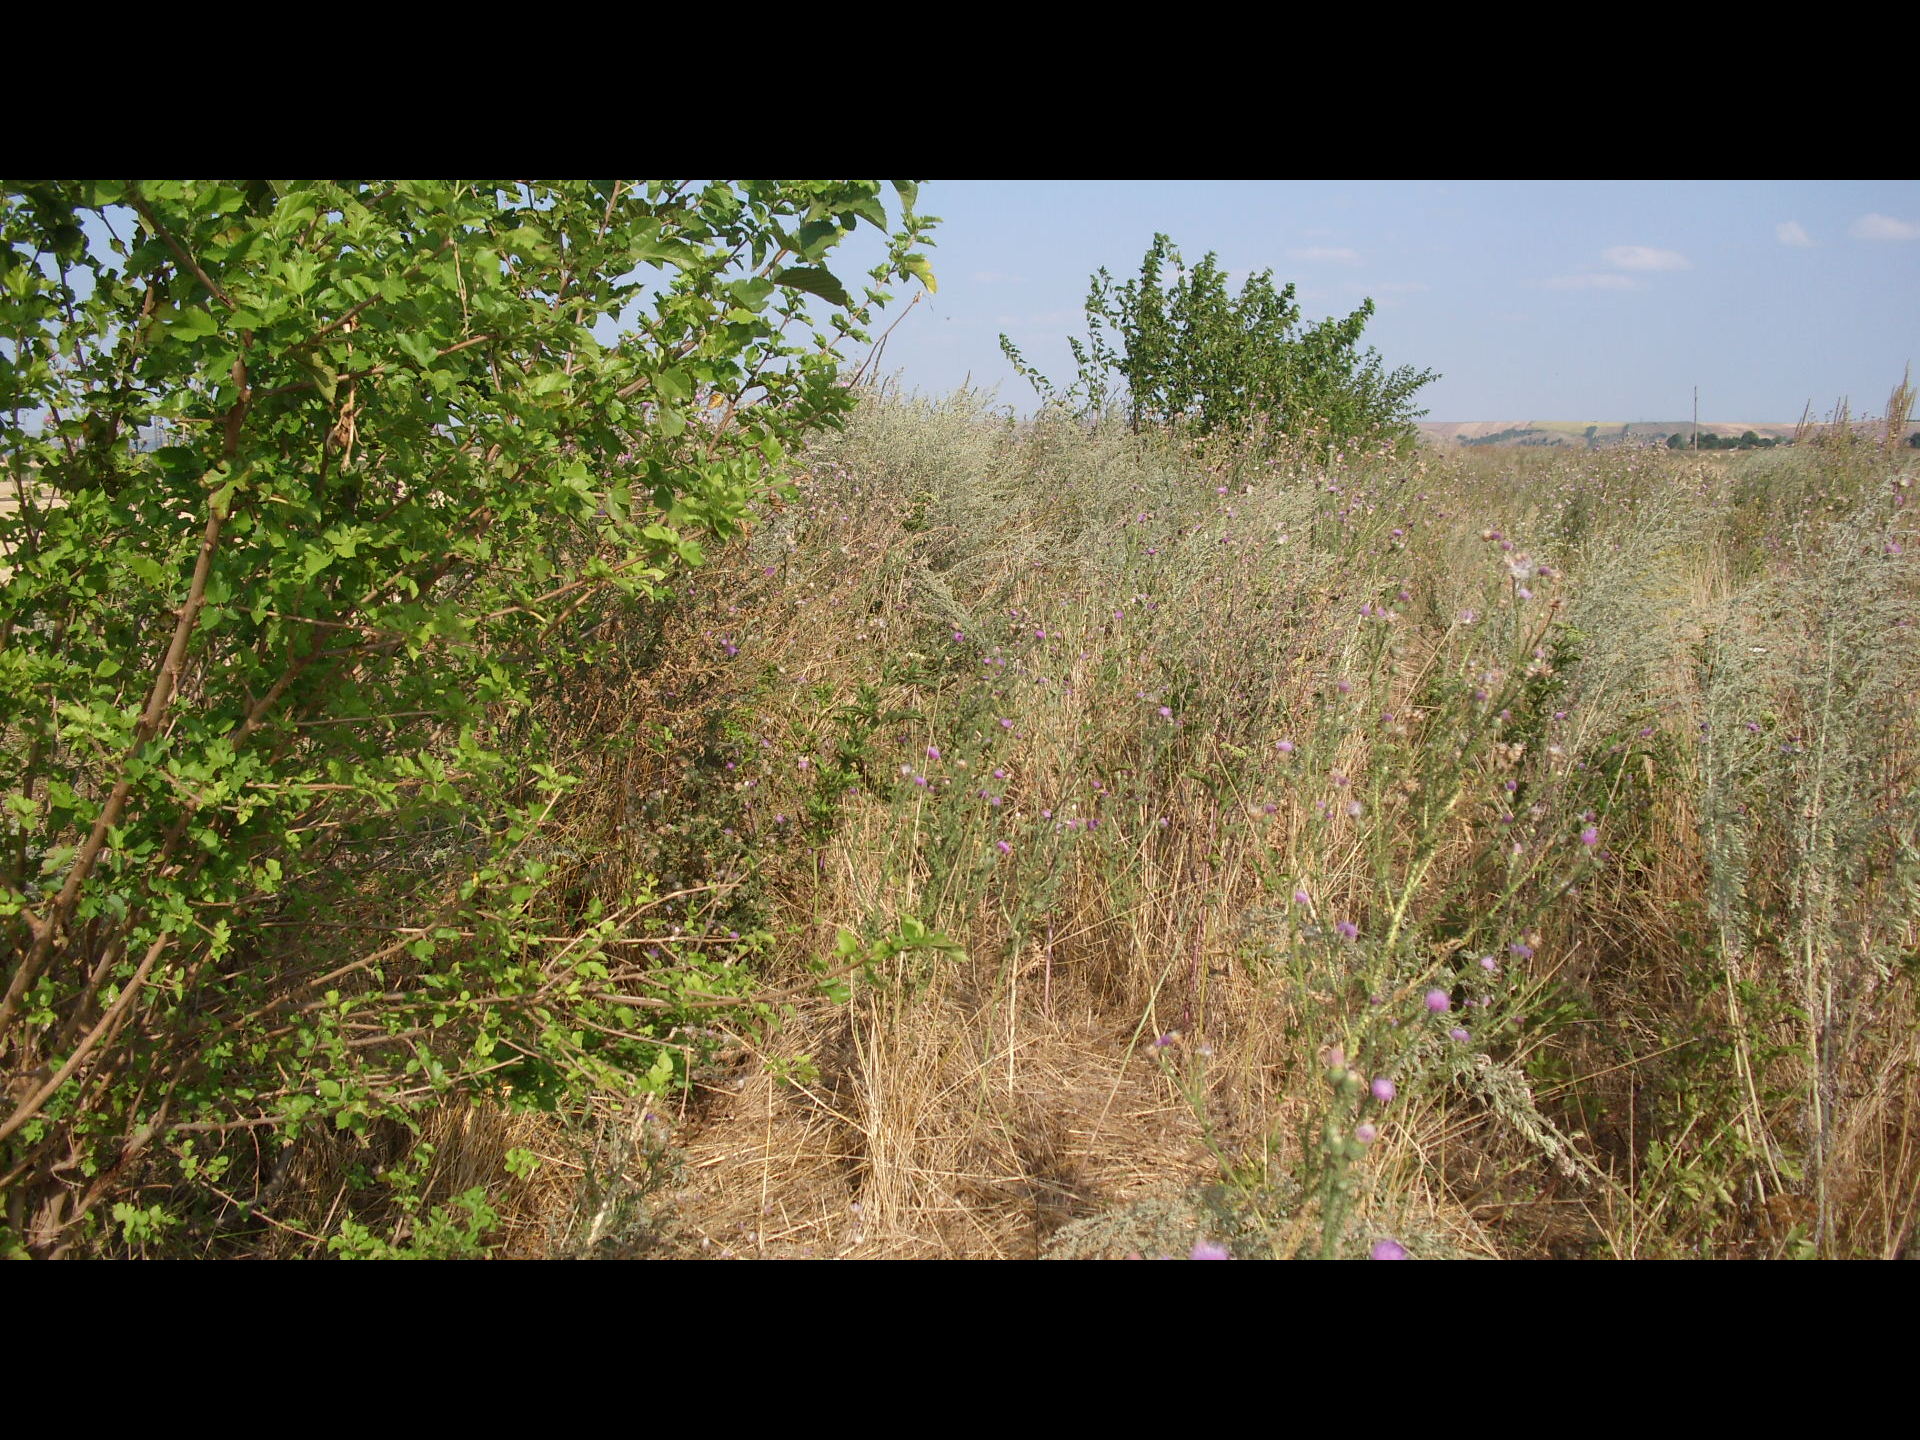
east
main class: Grassland
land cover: Grassland with sparse tree/shrub cover
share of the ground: > 75 %
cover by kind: herbaceous plants 85 %, shrubs 10 %, broadleaved forest trees 5 %
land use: Agriculture (excluding fallow land and kitchen gardens)
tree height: < 5 m
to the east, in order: Grassland with sparse tree/shrub cover; Common wheat
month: August
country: BG
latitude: 43.6672
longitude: 23.7542
